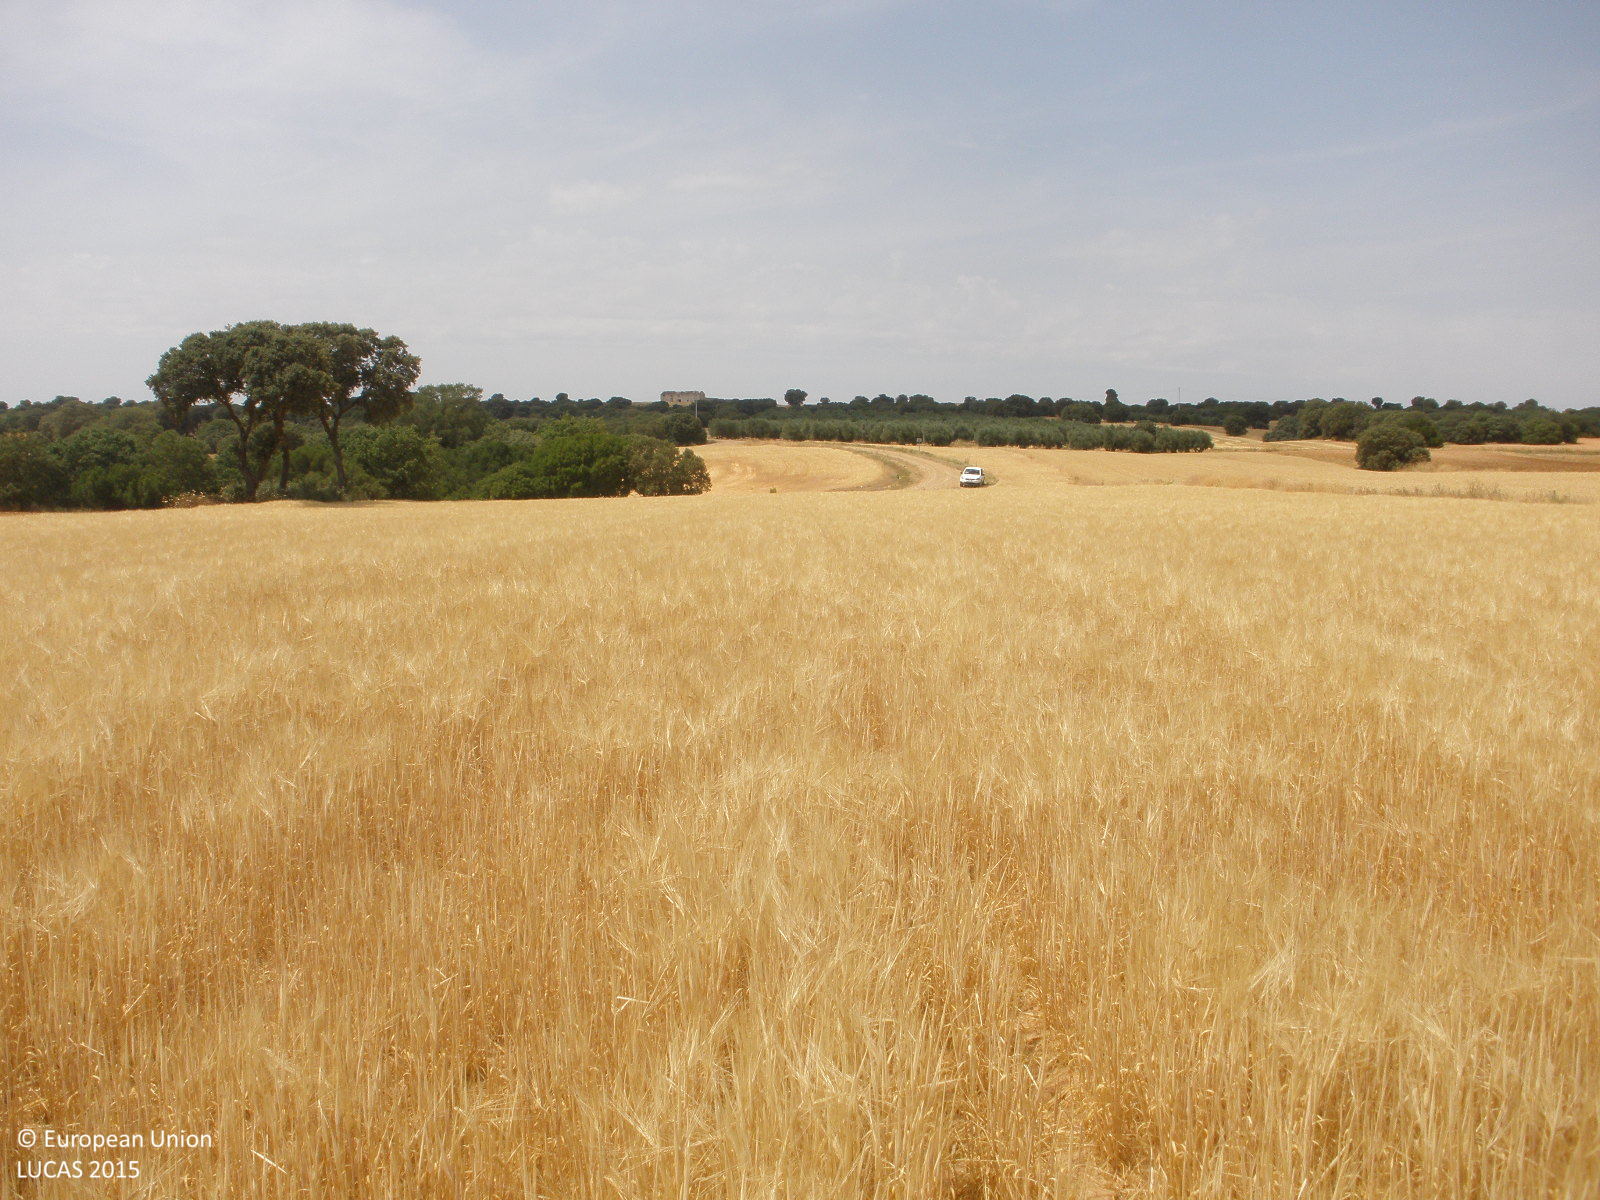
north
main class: Cropland
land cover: Barley
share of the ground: > 75 %
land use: Agriculture (excluding fallow land and kitchen gardens)
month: July
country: ES
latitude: 39.8320
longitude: -3.3104
